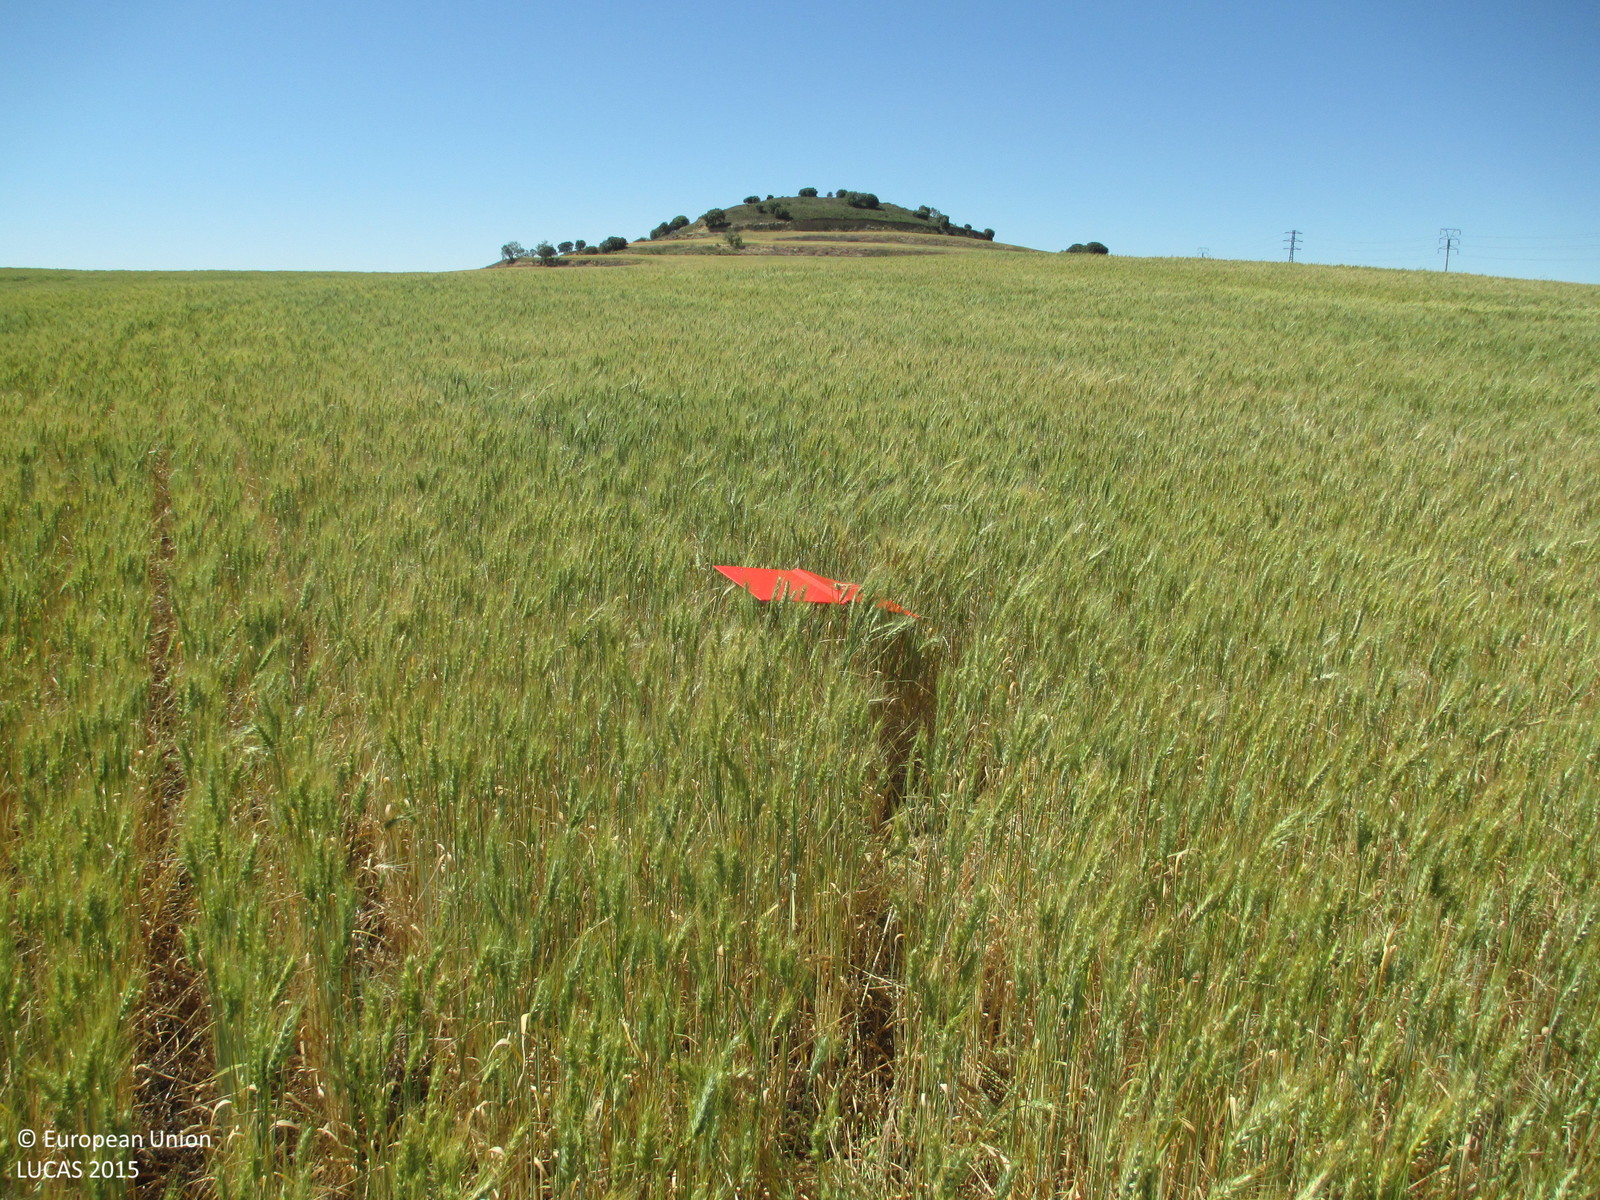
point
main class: Cropland
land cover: Durum wheat
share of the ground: > 75 %
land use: Agriculture (excluding fallow land and kitchen gardens)
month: May
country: ES
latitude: 42.0618
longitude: -0.2321
